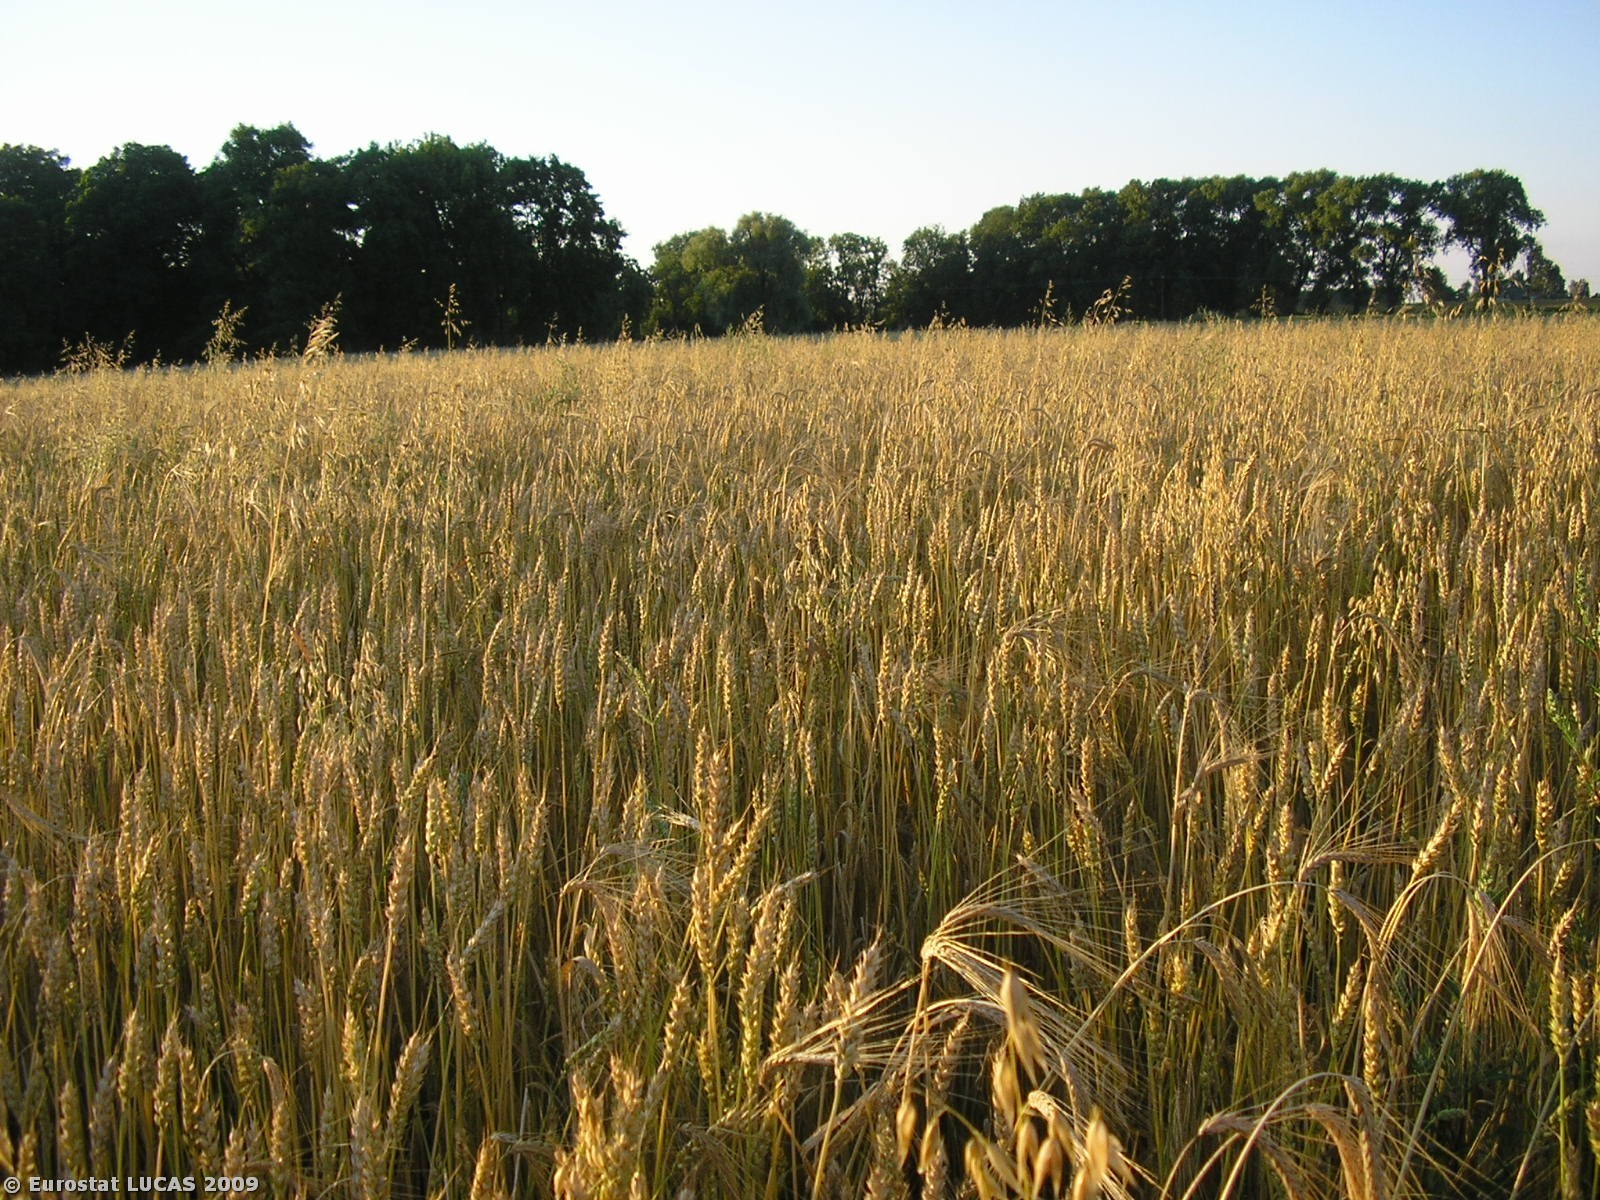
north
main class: Cropland
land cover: Mixed cereals for fodder
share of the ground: > 75 %
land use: Agriculture (excluding fallow land and kitchen gardens)
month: July
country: PL
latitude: 52.3895
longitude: 22.3031
